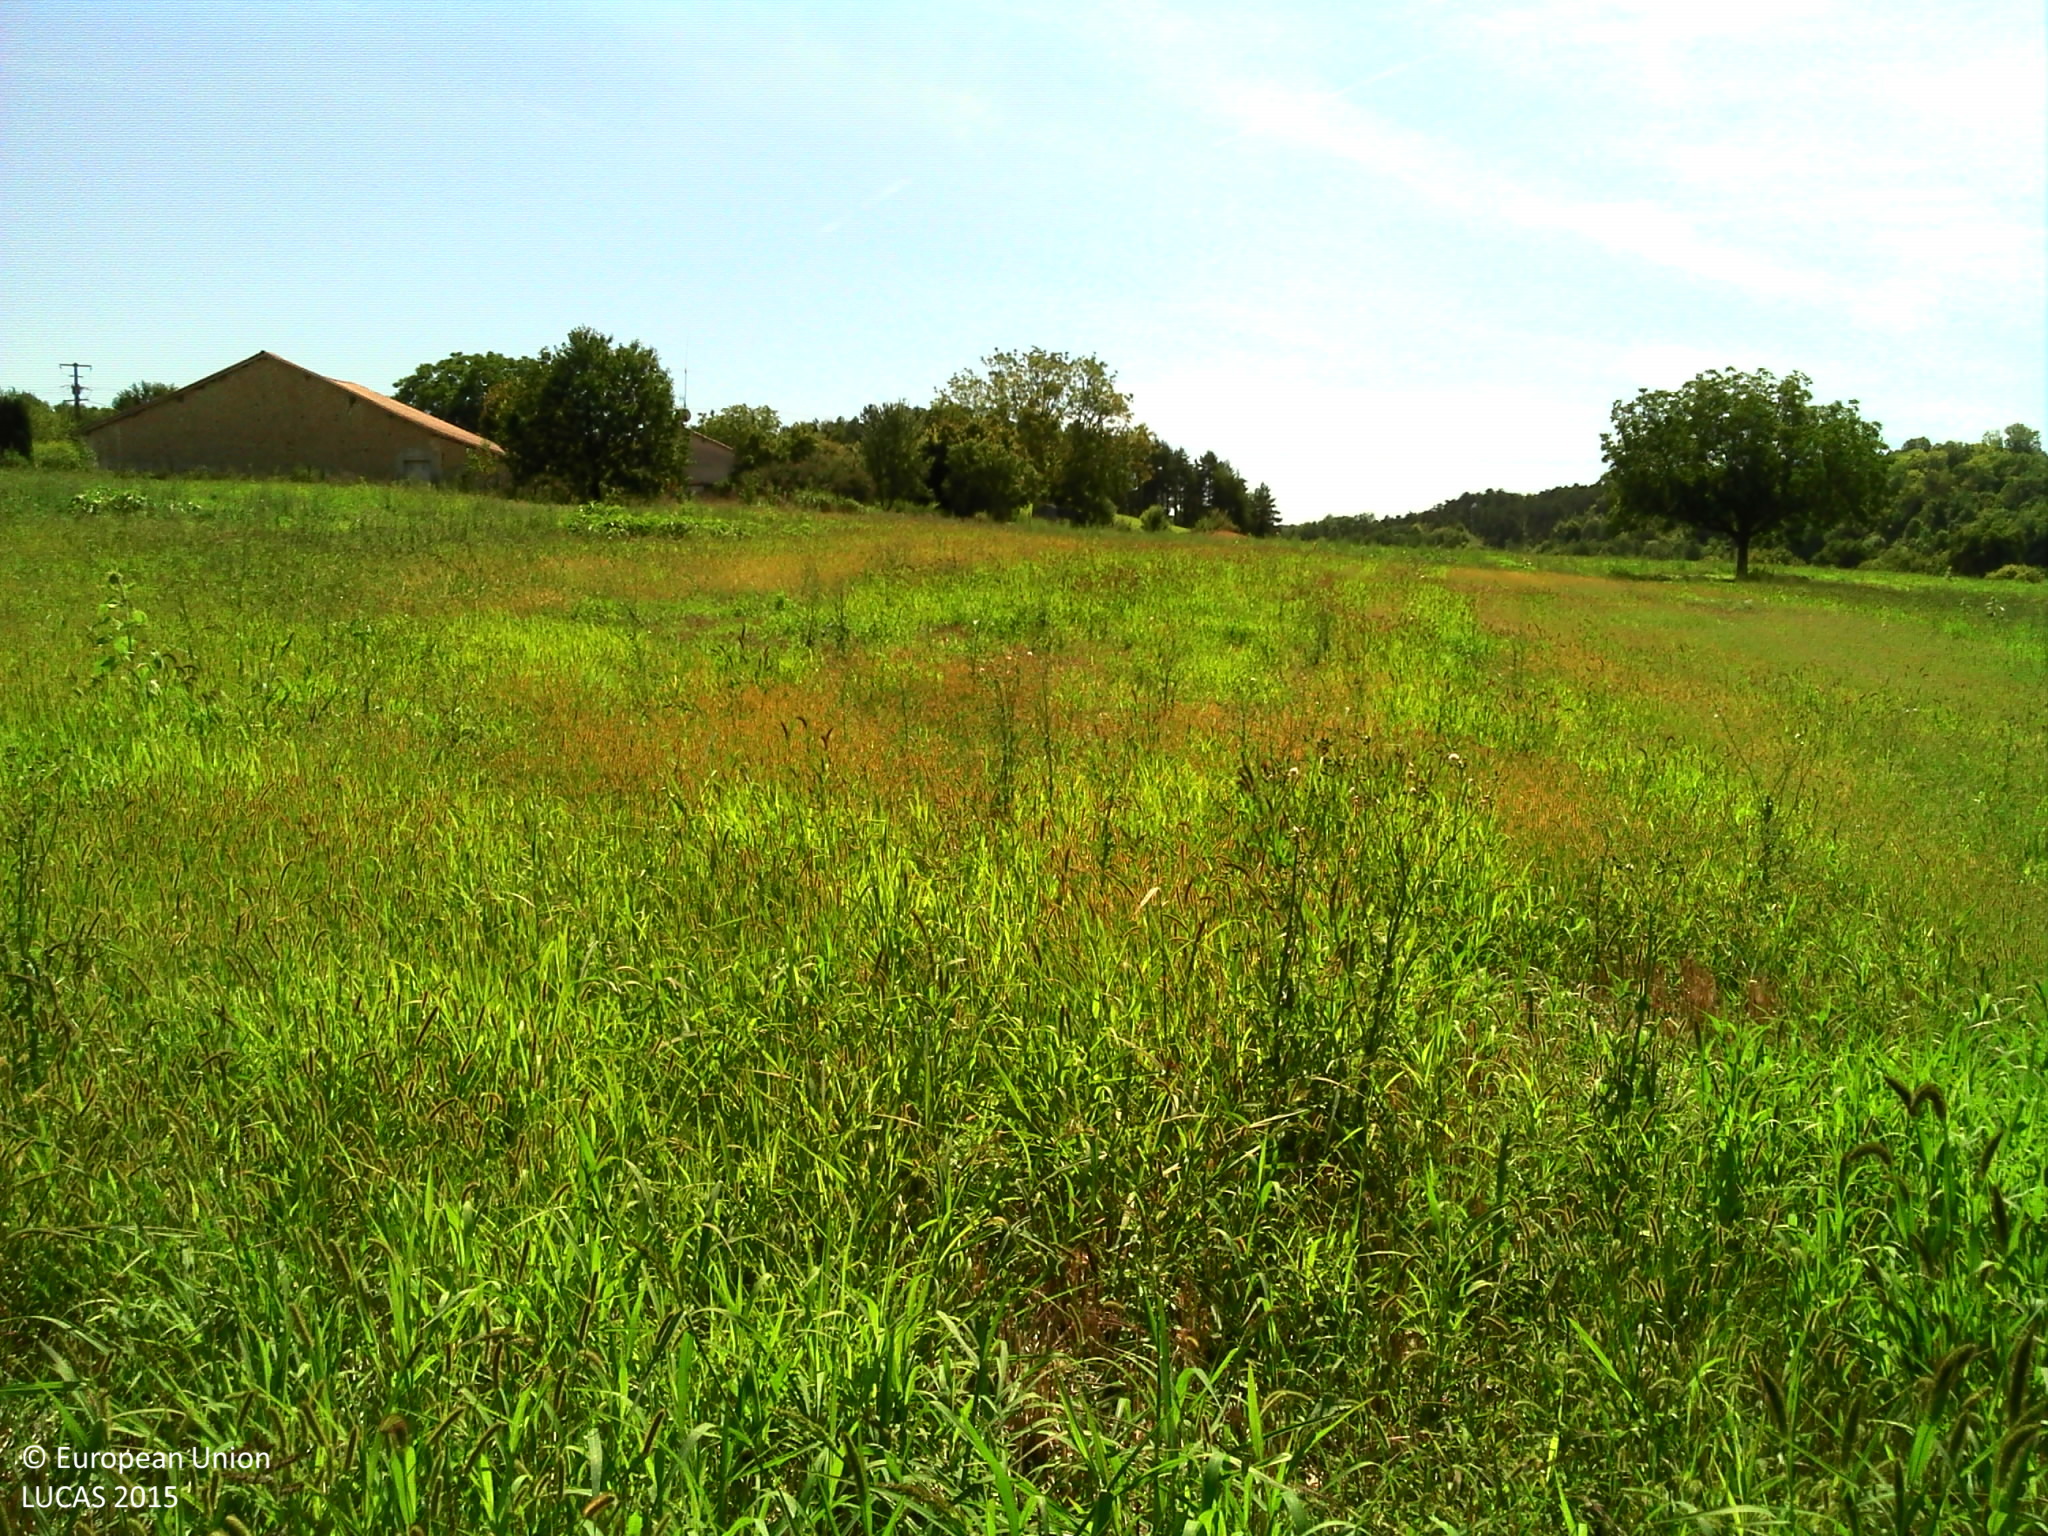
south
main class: Grassland
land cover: Grassland without tree/shrub cover
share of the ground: > 75 %
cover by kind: herbaceous plants 100 %
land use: Agriculture (excluding fallow land and kitchen gardens)
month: August
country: FR
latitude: 45.2382
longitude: 0.4979
